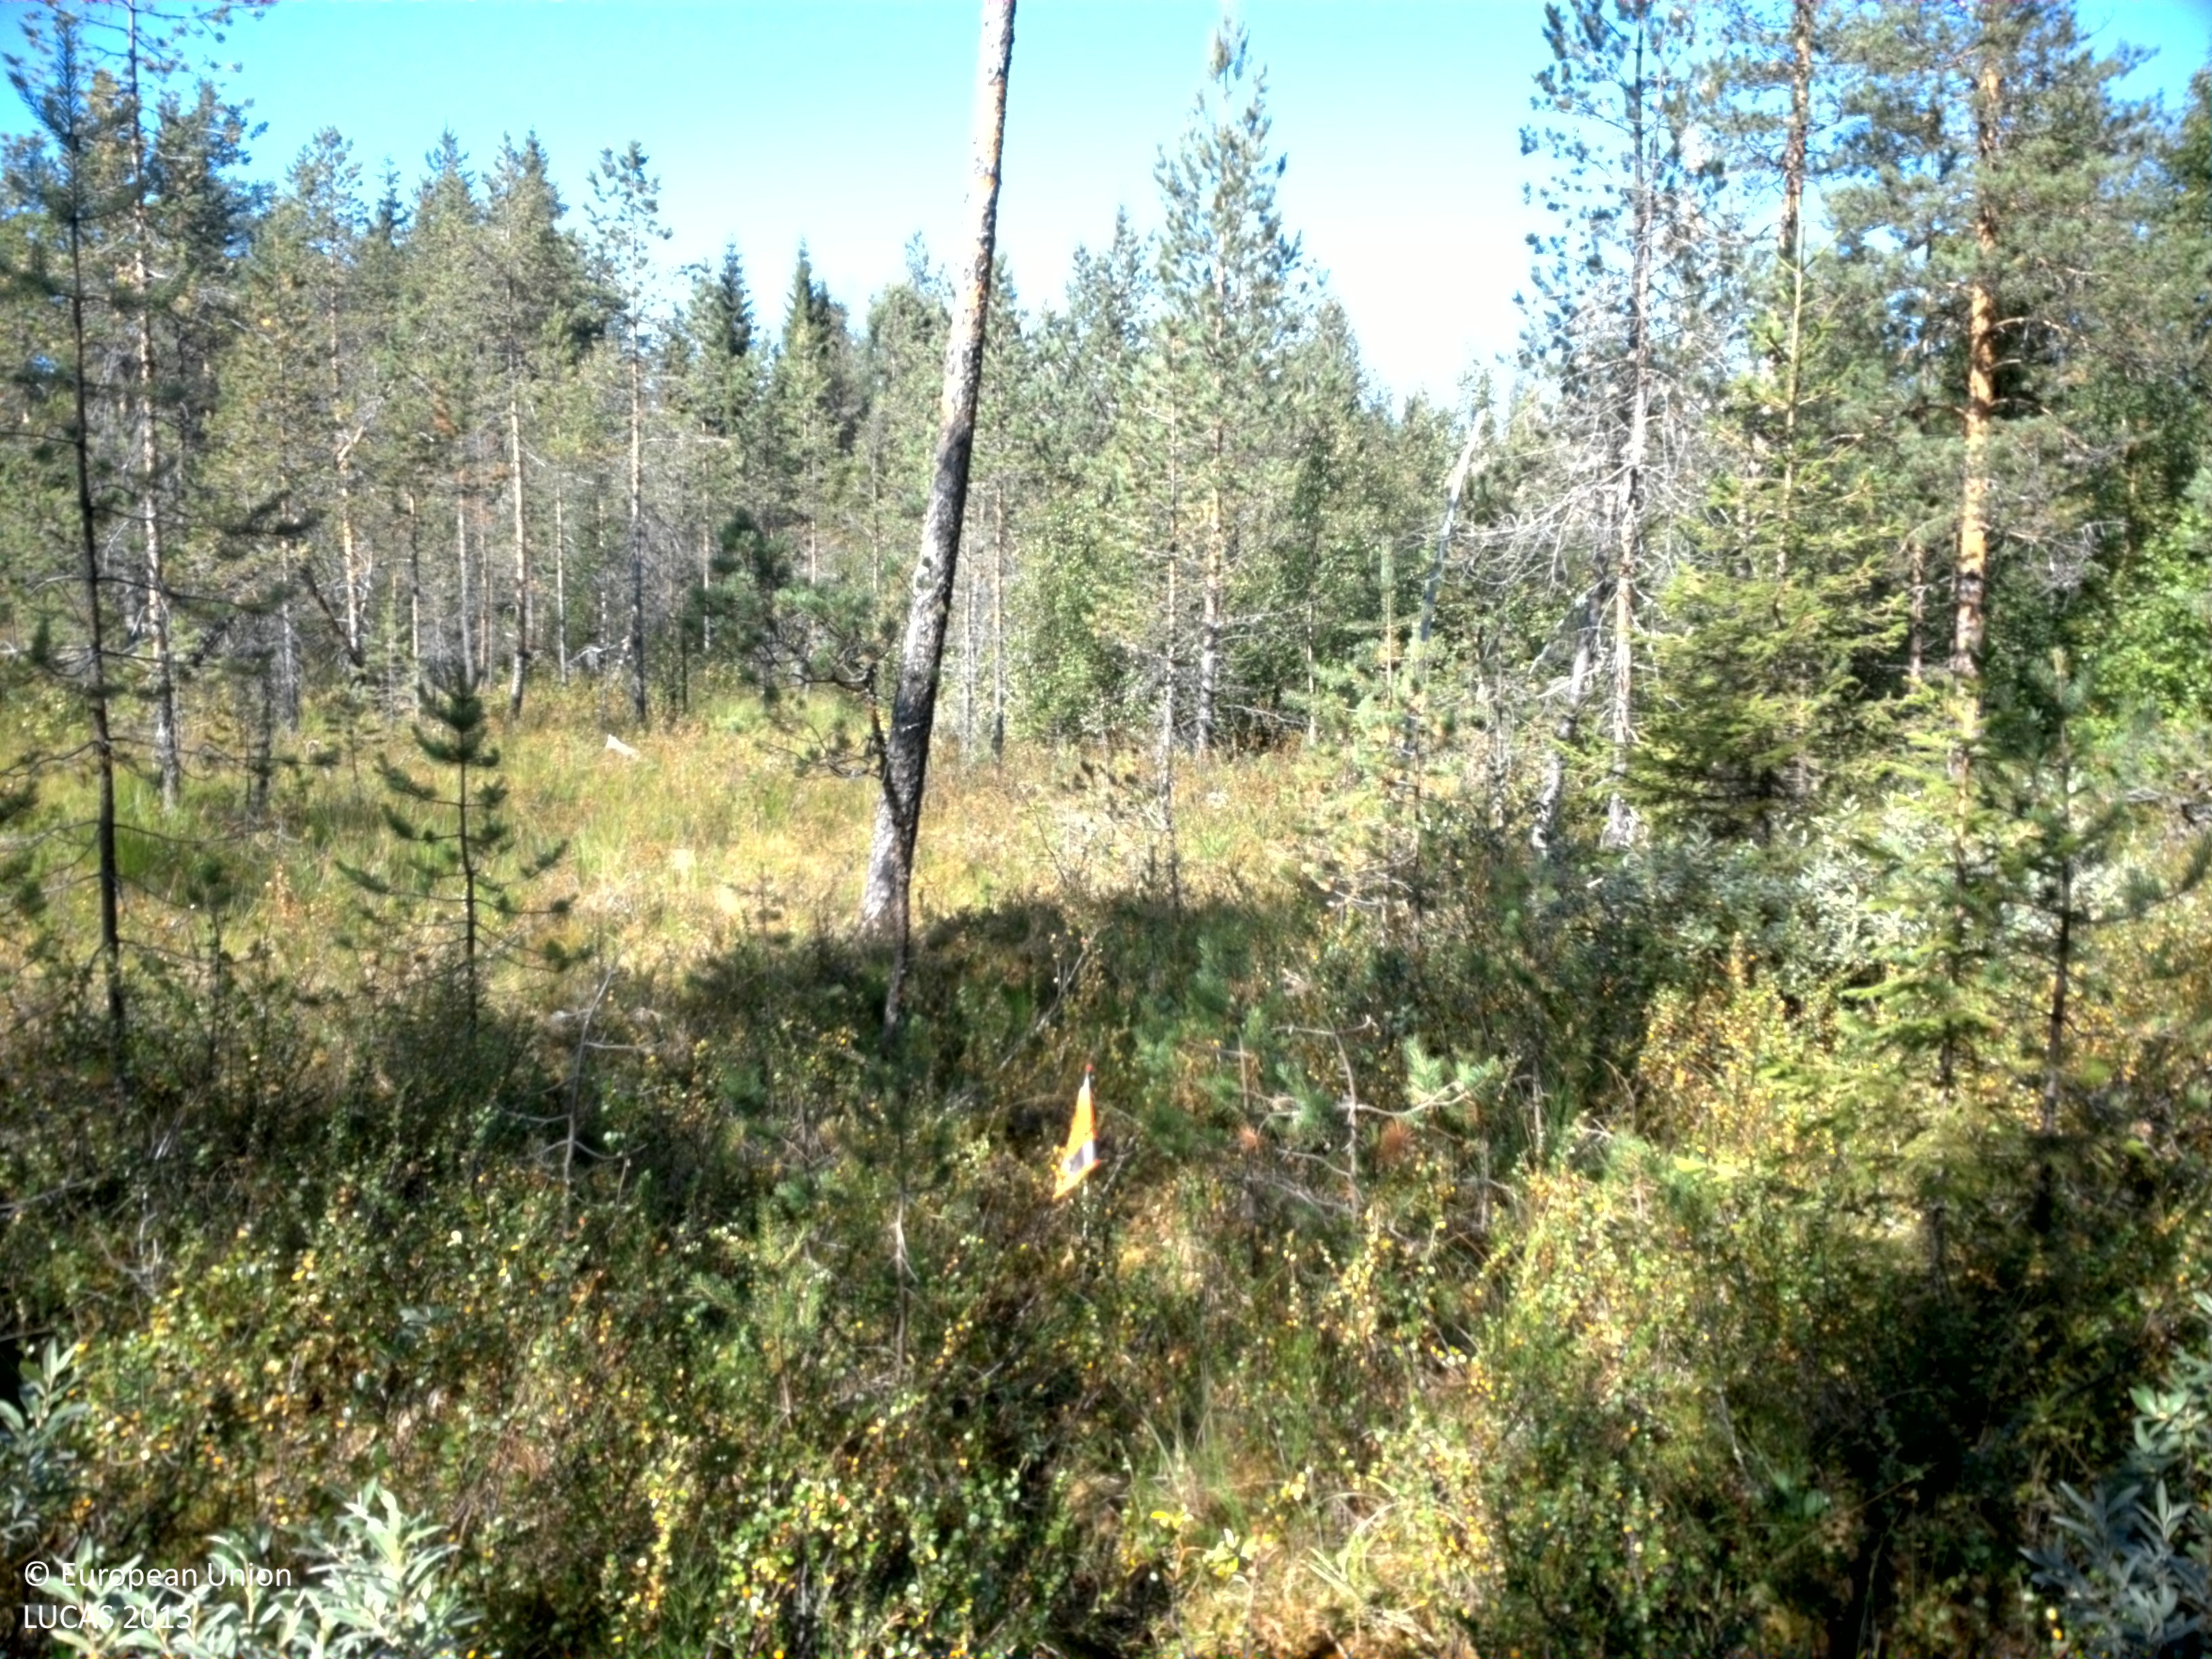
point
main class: Woodland
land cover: Pine dominated coniferous woodland
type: mire and swamp forests
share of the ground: 10 - 25 %
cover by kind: shrubs 45 %, coniferous forest trees 20 %, herbaceous plants 20 %, lichens and mosses 15 %
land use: Semi-natural and natural areas not in use
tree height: > 5 m
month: August
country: SE
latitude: 64.6483
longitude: 16.4350
